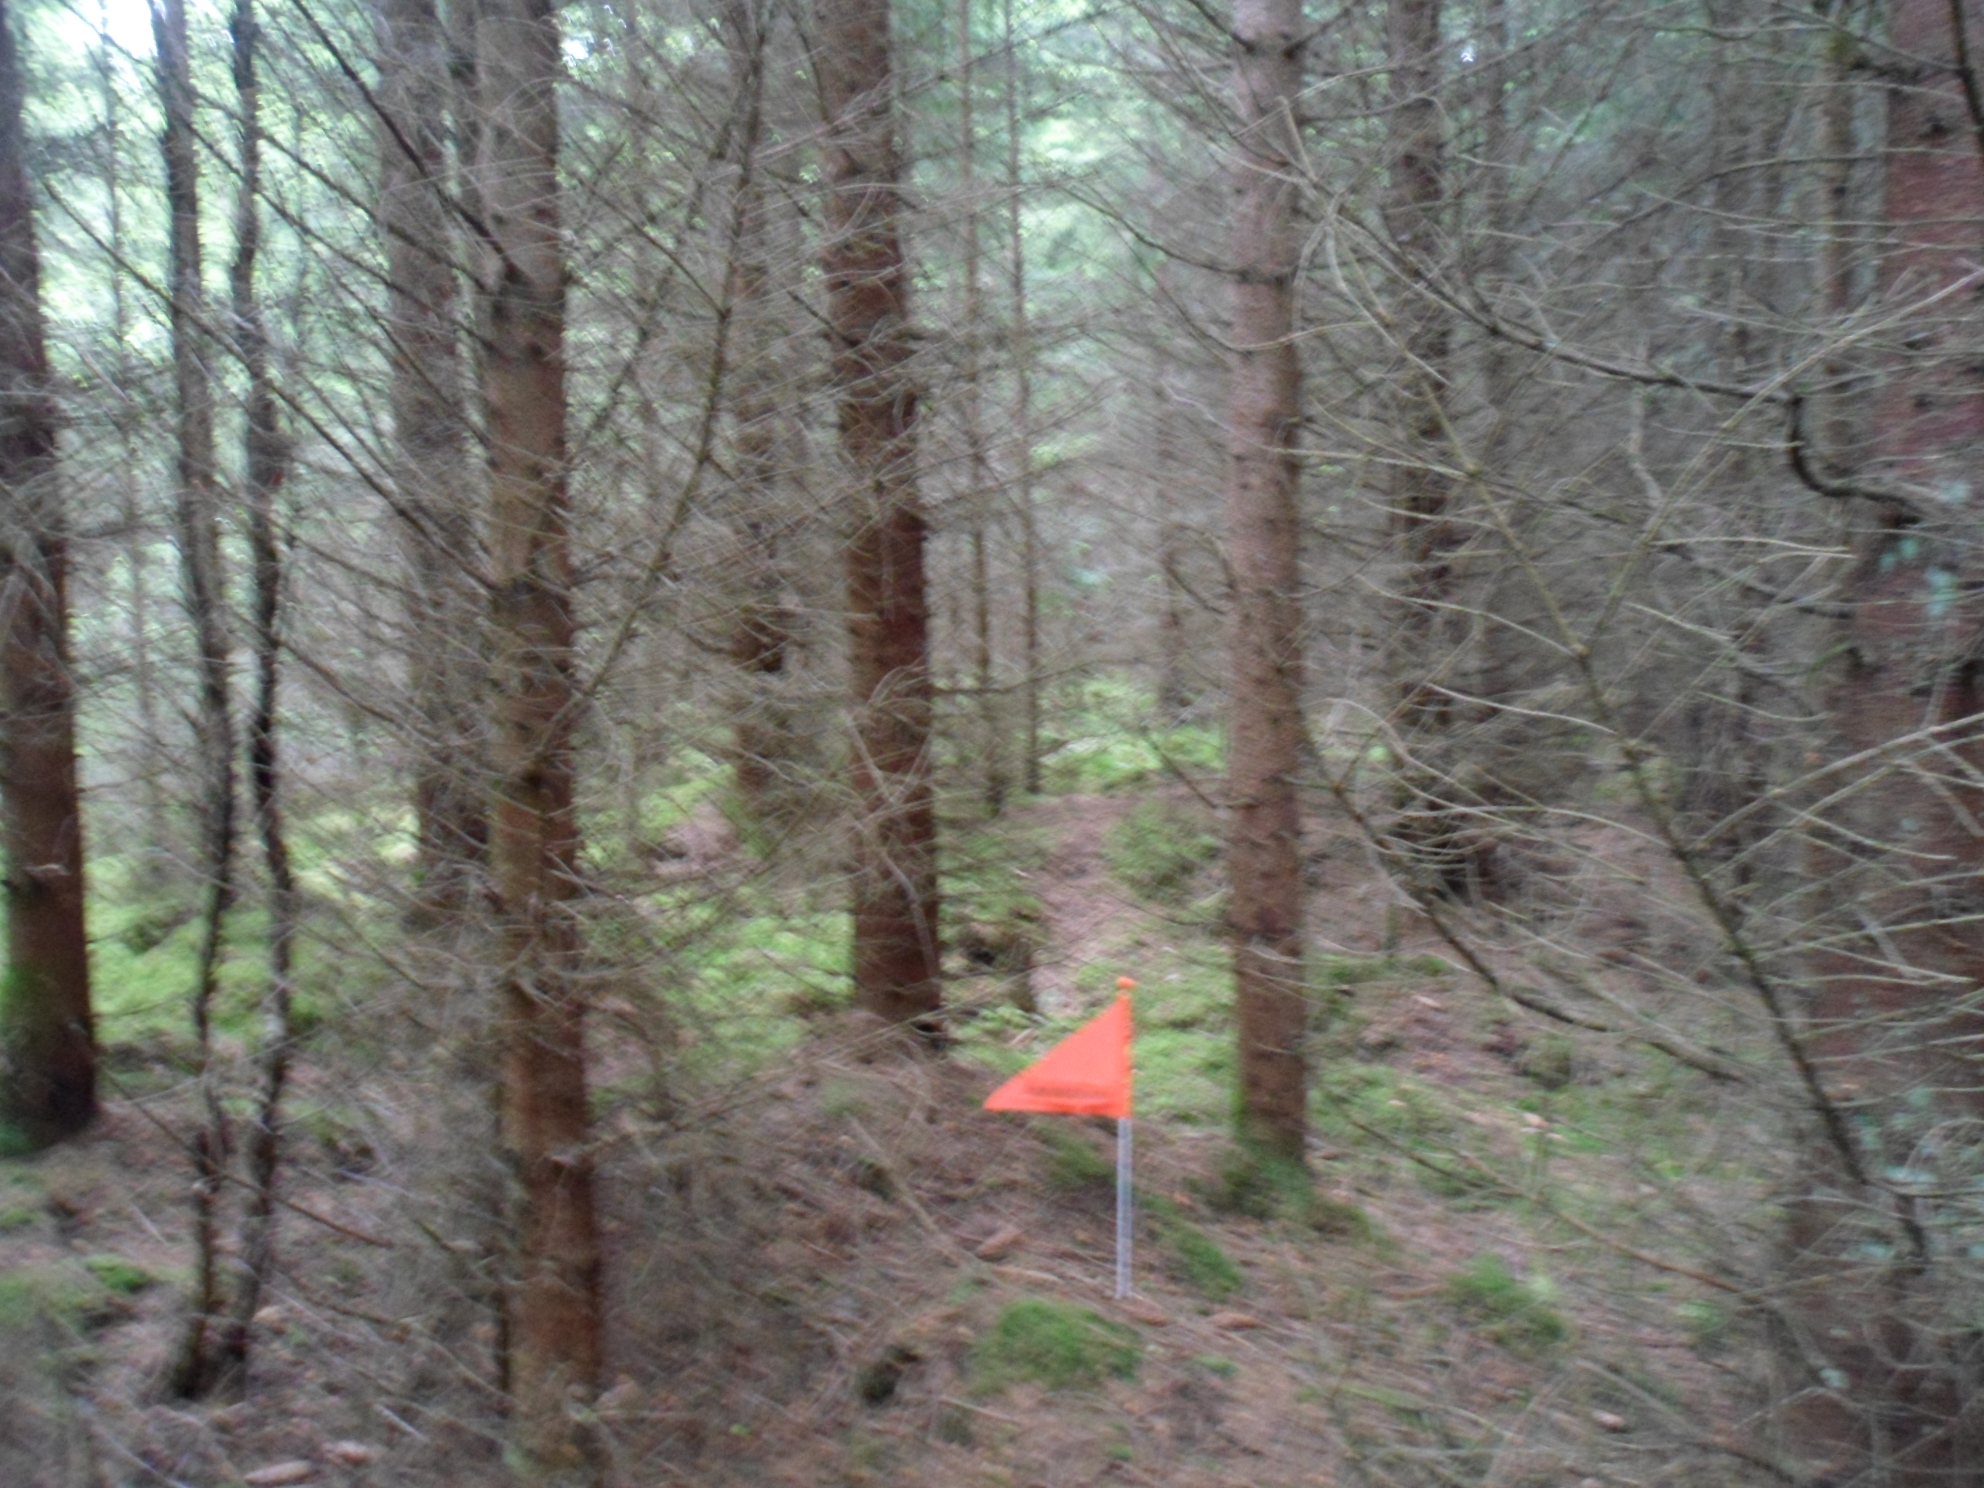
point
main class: Woodland
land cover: Spruce dominated coniferous woodland
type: boreal forest
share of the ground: > 75 %
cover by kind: coniferous forest trees 75 %, lichens and mosses 10 %, broadleaved forest trees 5 %, shrubs 5 %, herbaceous plants 5 %
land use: Forestry
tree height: > 5 m
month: June
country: SE
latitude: 57.1302
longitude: 14.1098
